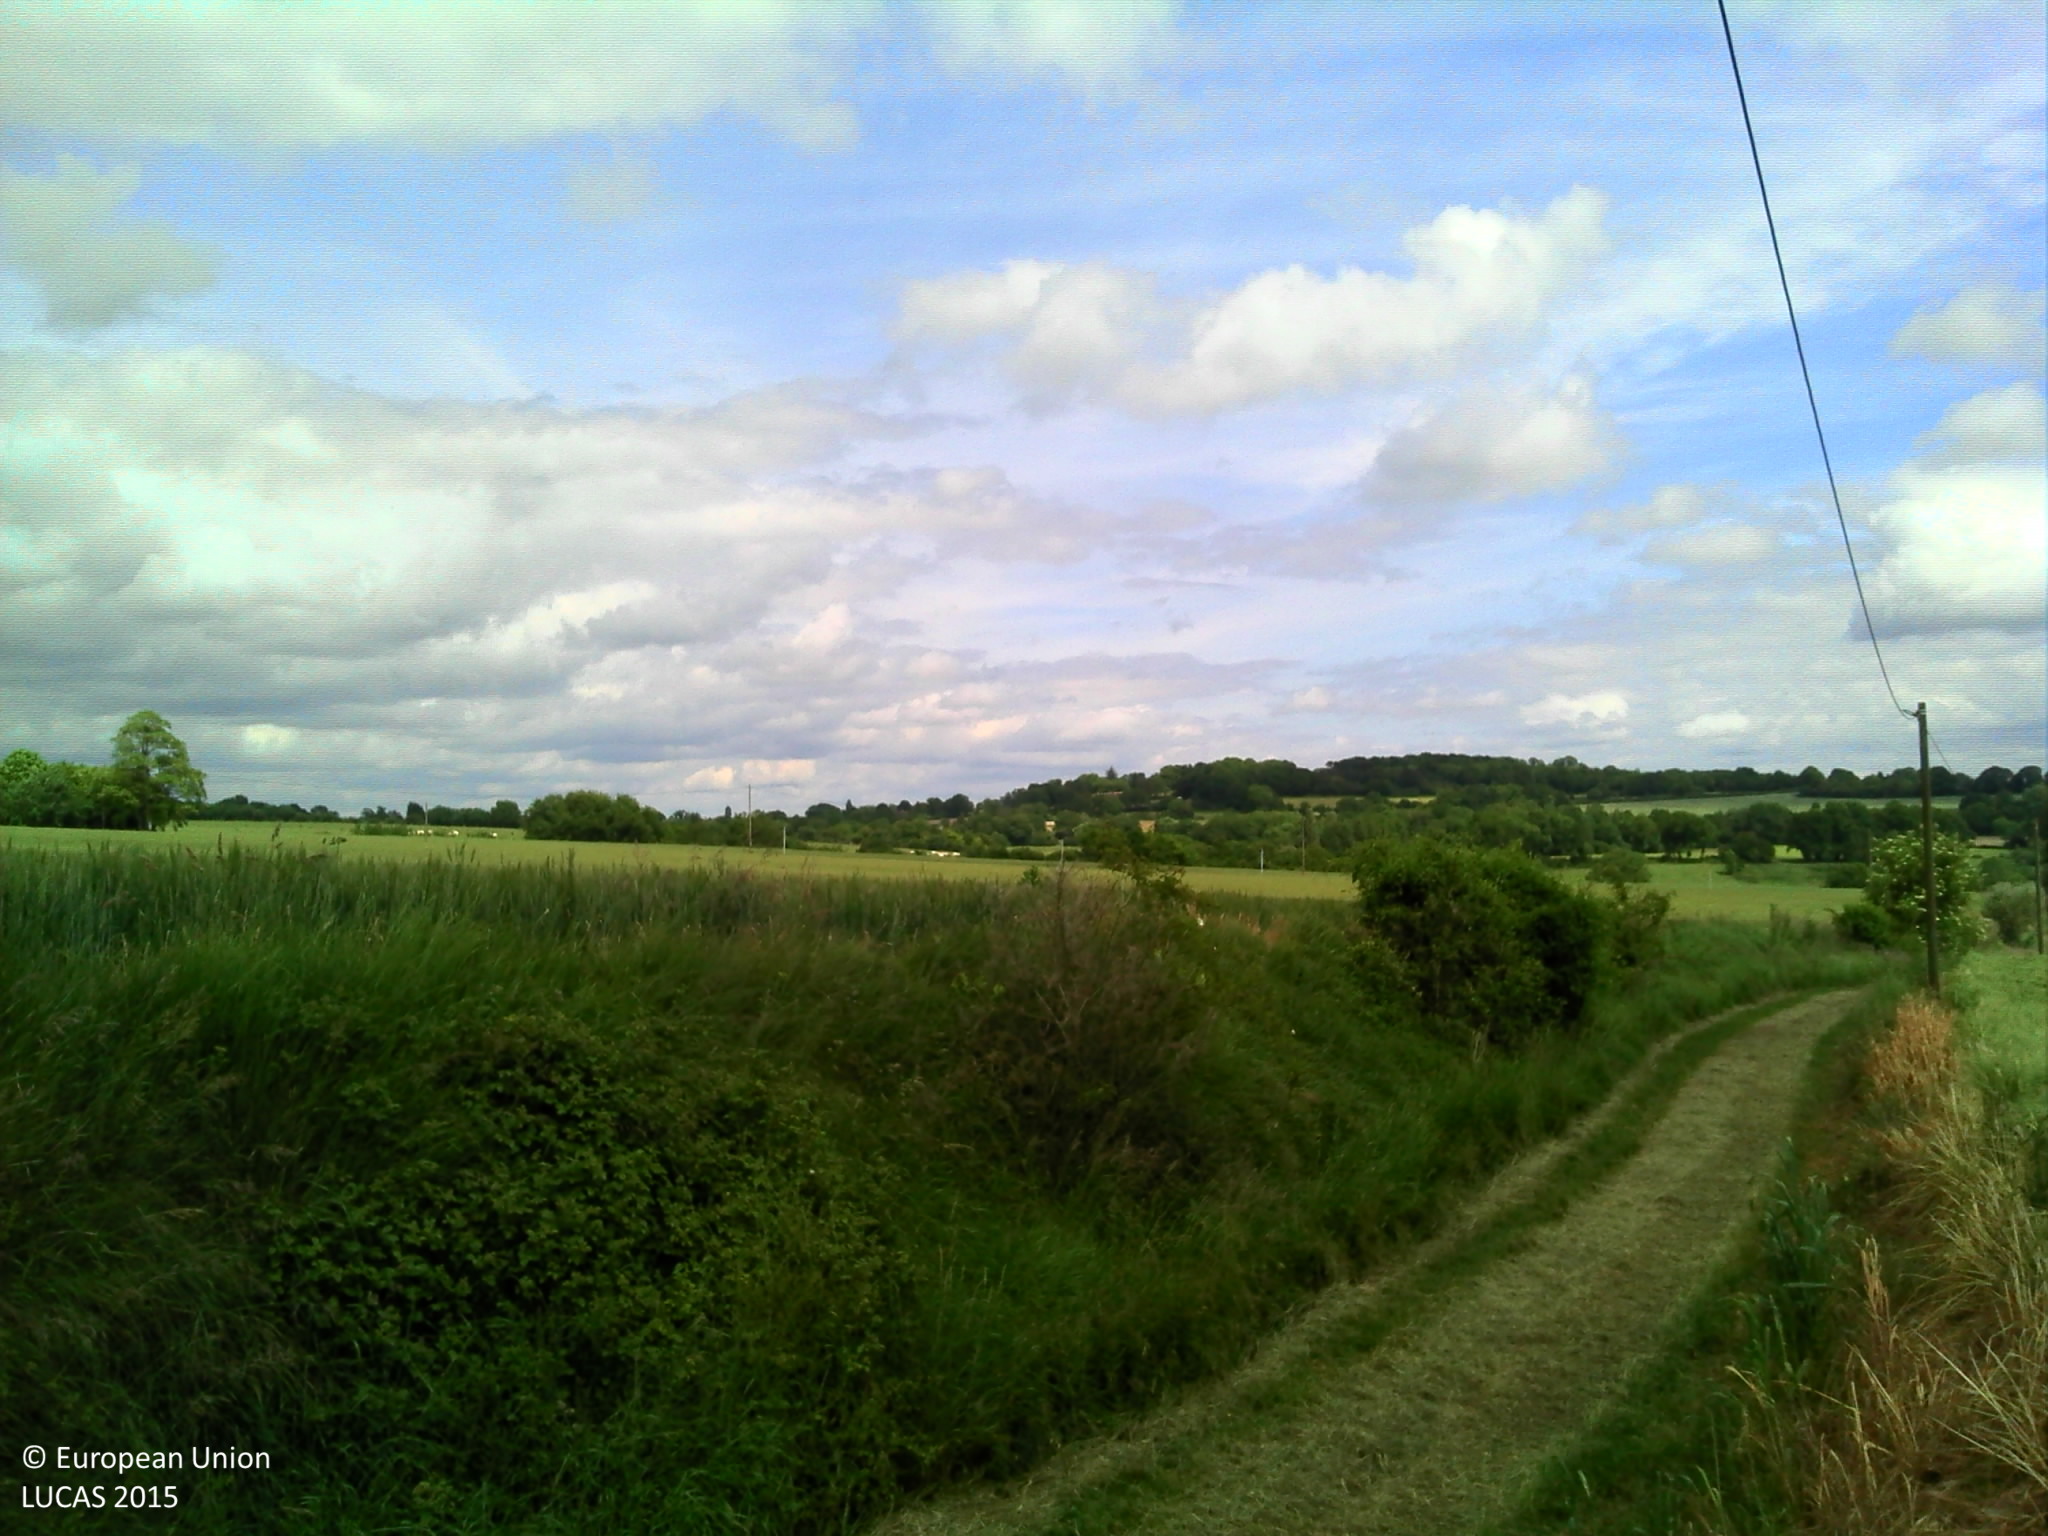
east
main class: Cropland
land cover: Barley
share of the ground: > 75 %
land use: Agriculture (excluding fallow land and kitchen gardens)
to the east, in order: Barley; Electric lines; Barley; Ditches and canals; Triticale
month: May
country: FR
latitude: 48.0759
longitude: -0.0009
